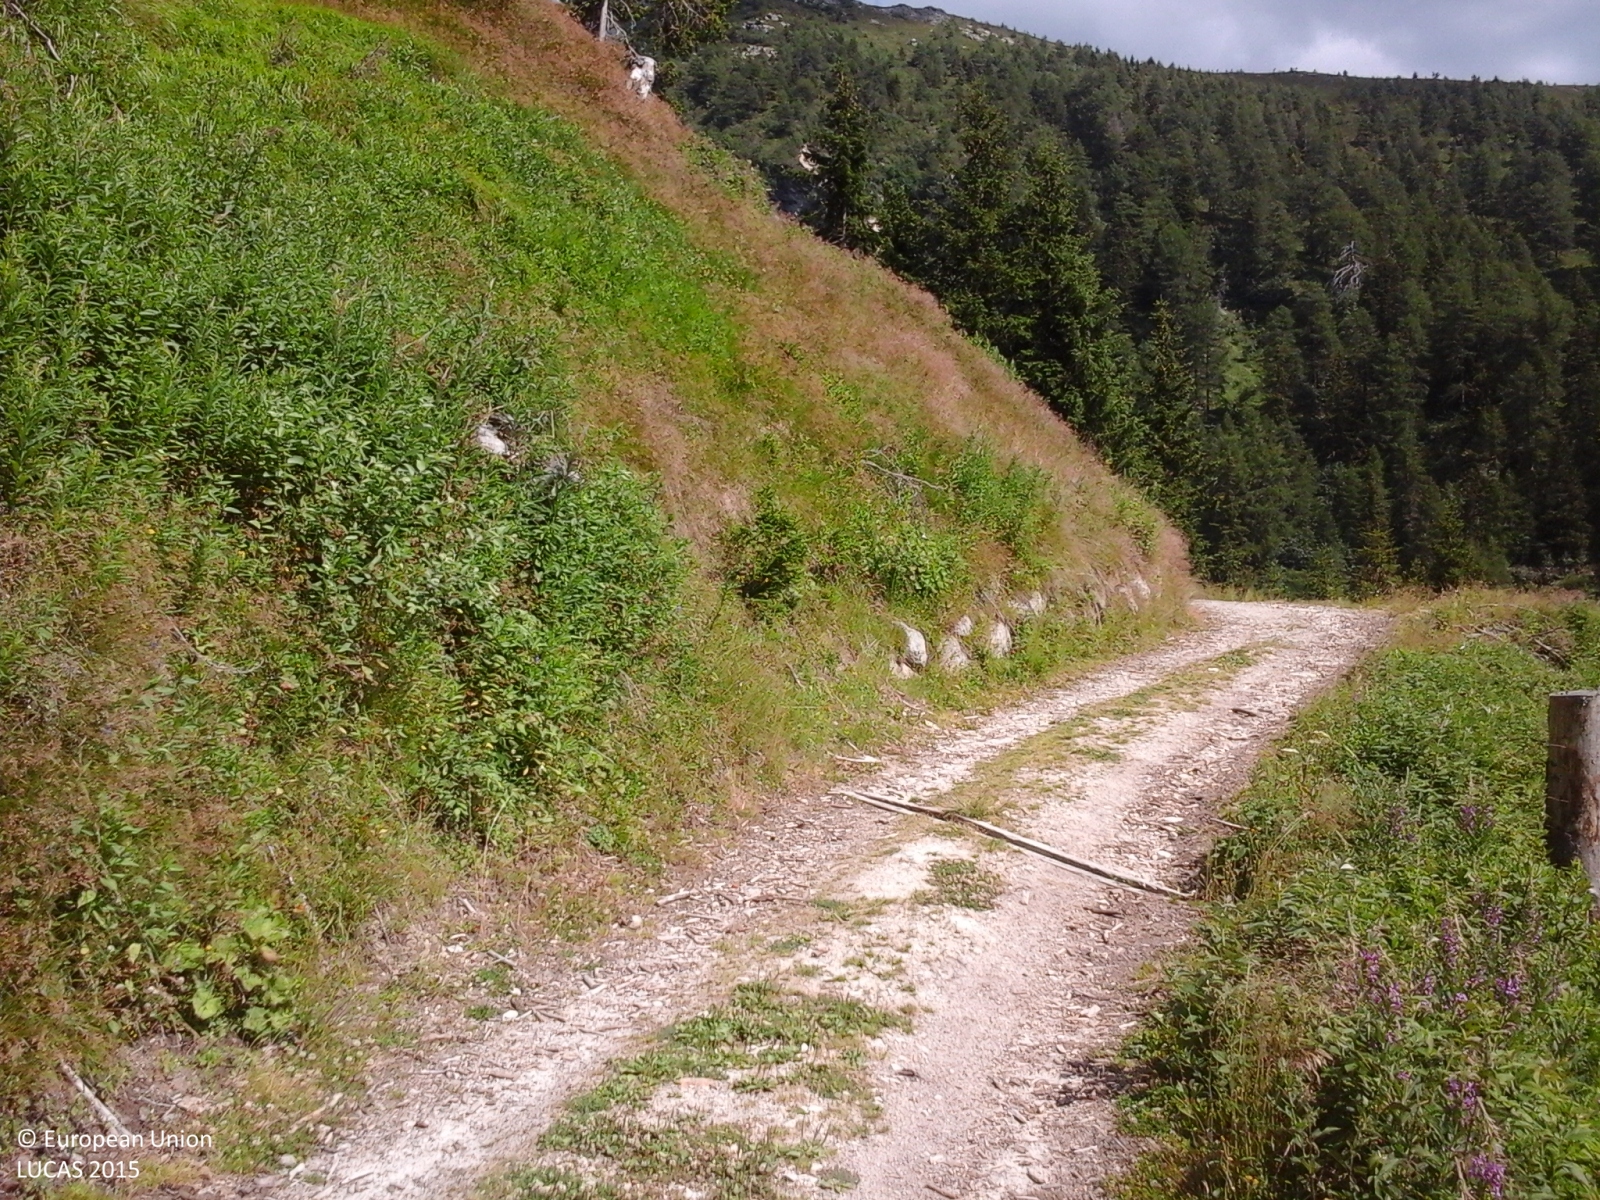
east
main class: Woodland
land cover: Spruce dominated coniferous woodland
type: alpine coniferous forest
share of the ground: > 75 %
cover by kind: coniferous forest trees 100 %
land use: Semi-natural and natural areas not in use
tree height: > 5 m
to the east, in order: Spruce dominated coniferous woodland
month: July
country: IT
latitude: 46.8438
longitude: 11.5850
